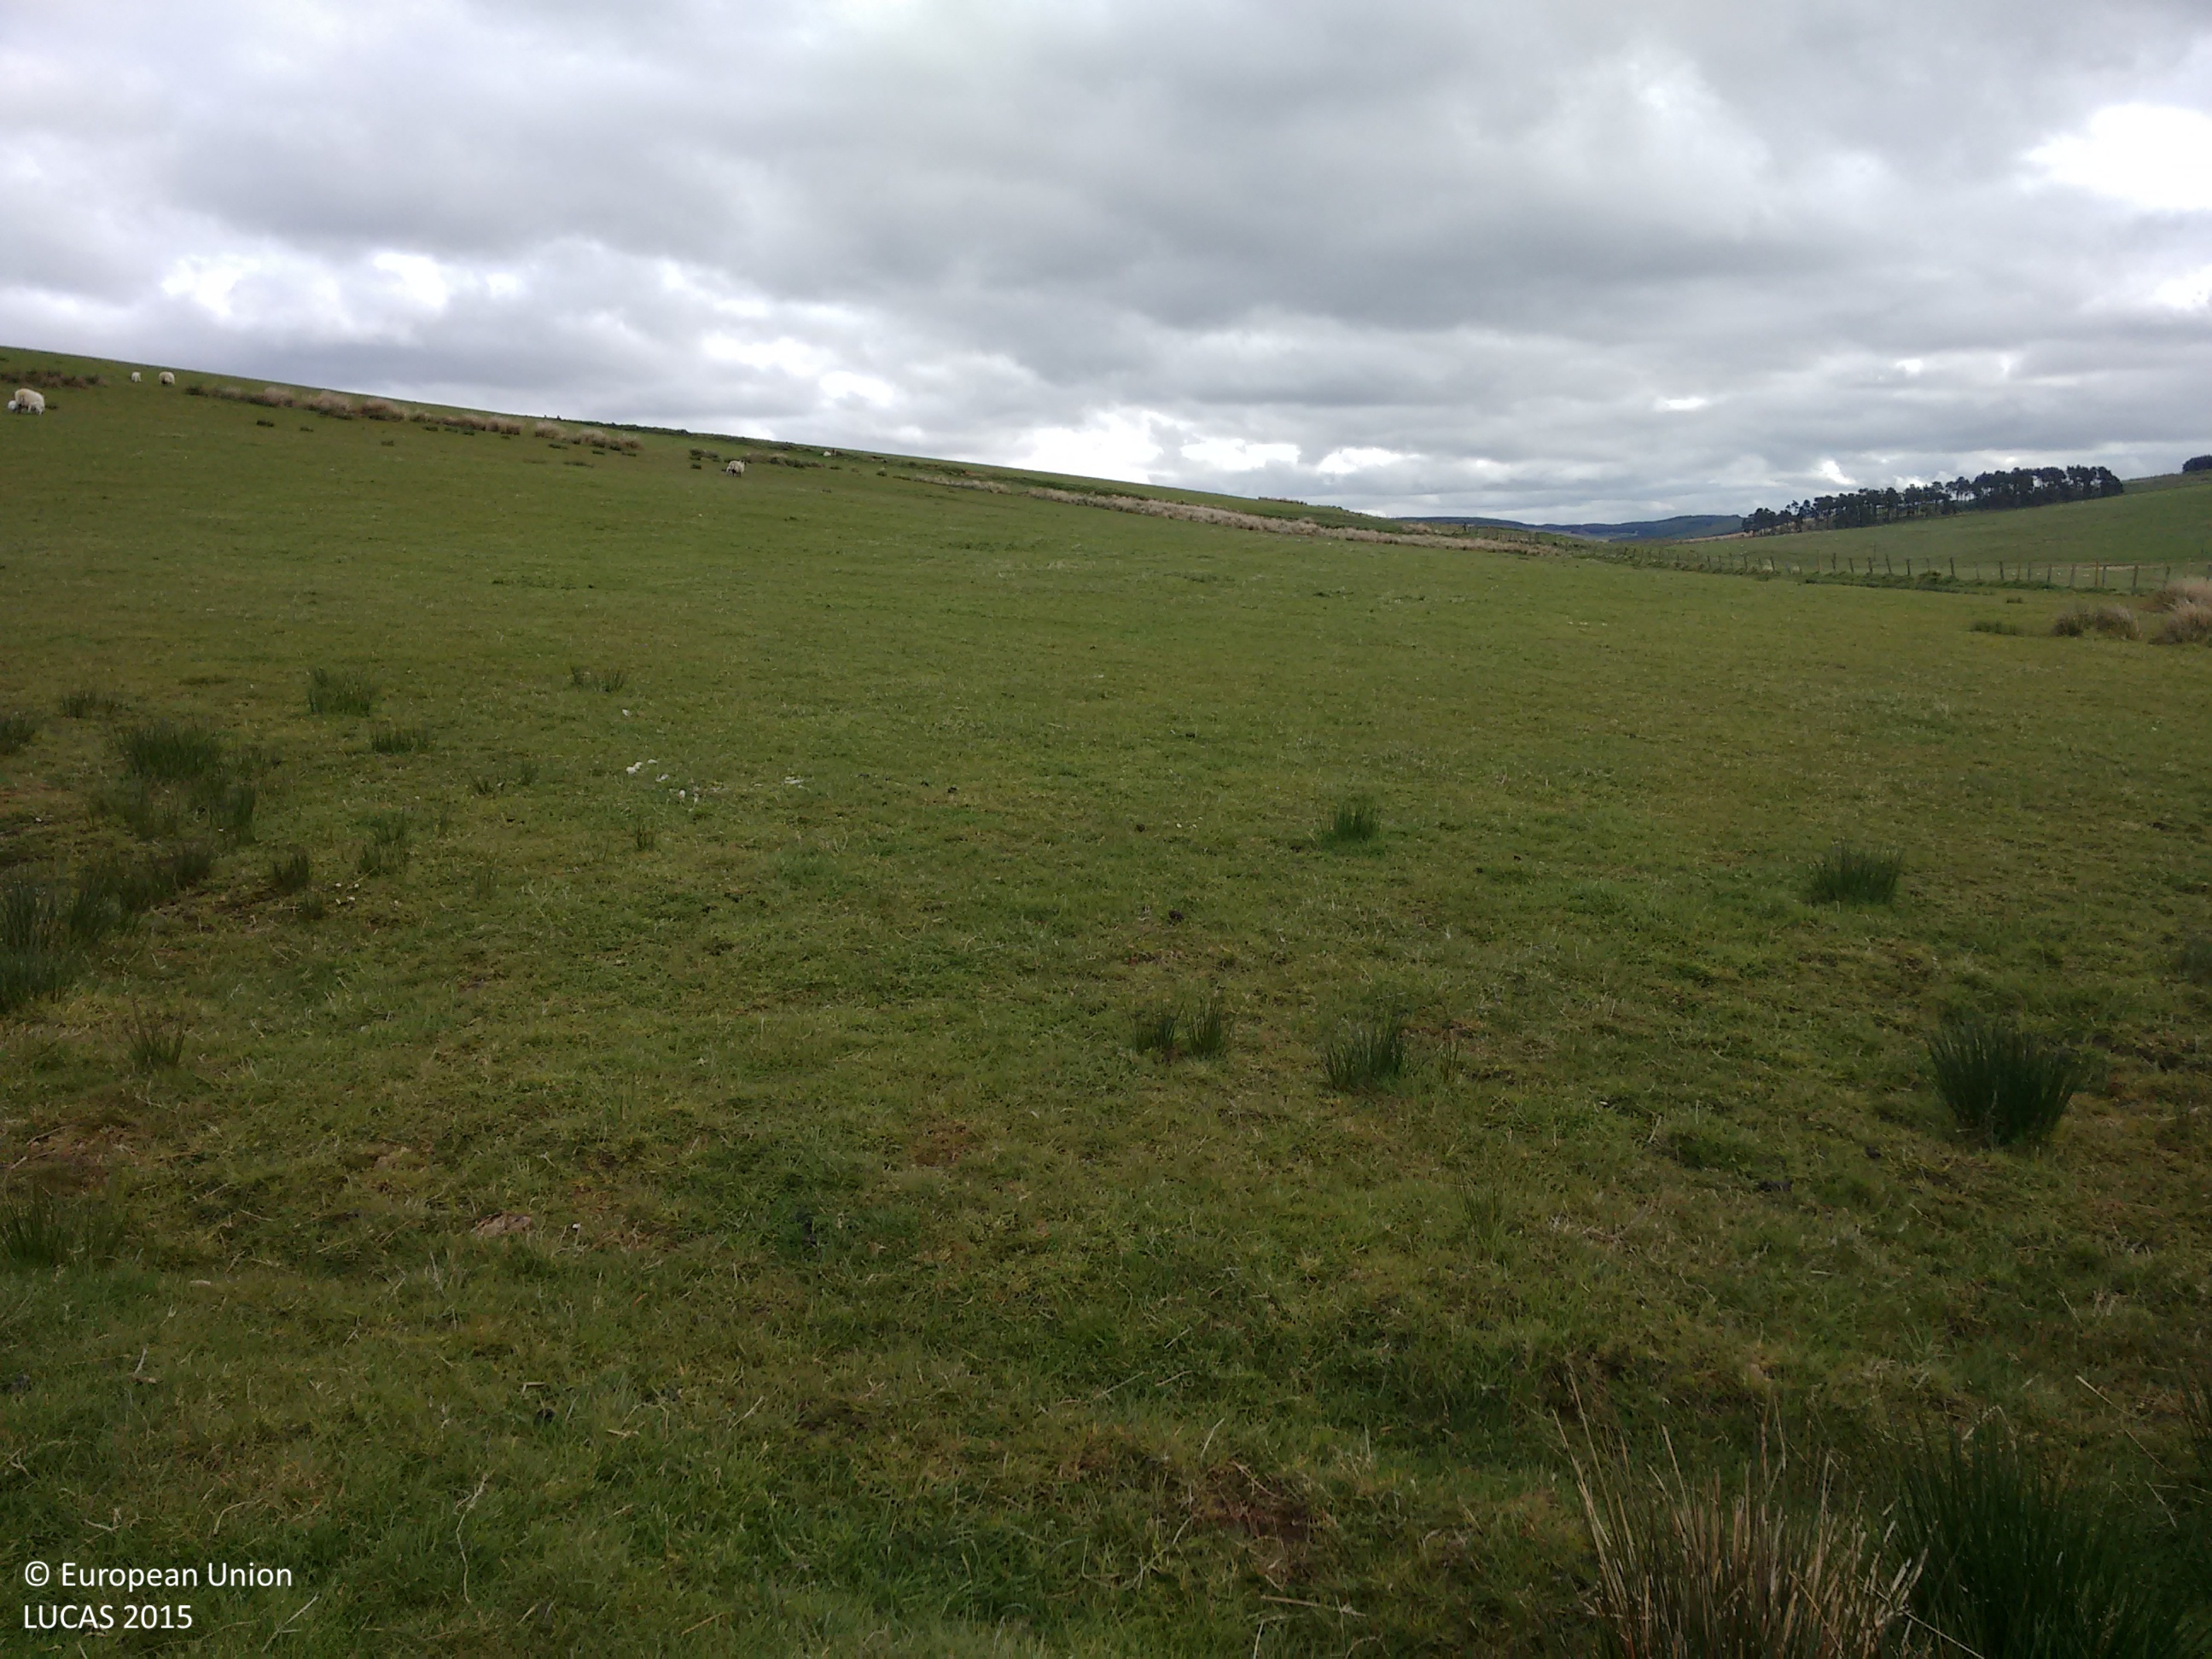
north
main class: Grassland
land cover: Grassland without tree/shrub cover
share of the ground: > 75 %
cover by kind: herbaceous plants 100 %
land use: Agriculture (excluding fallow land and kitchen gardens)
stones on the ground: < 10 %
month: May
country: GB
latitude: 55.2259
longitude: -2.1460
